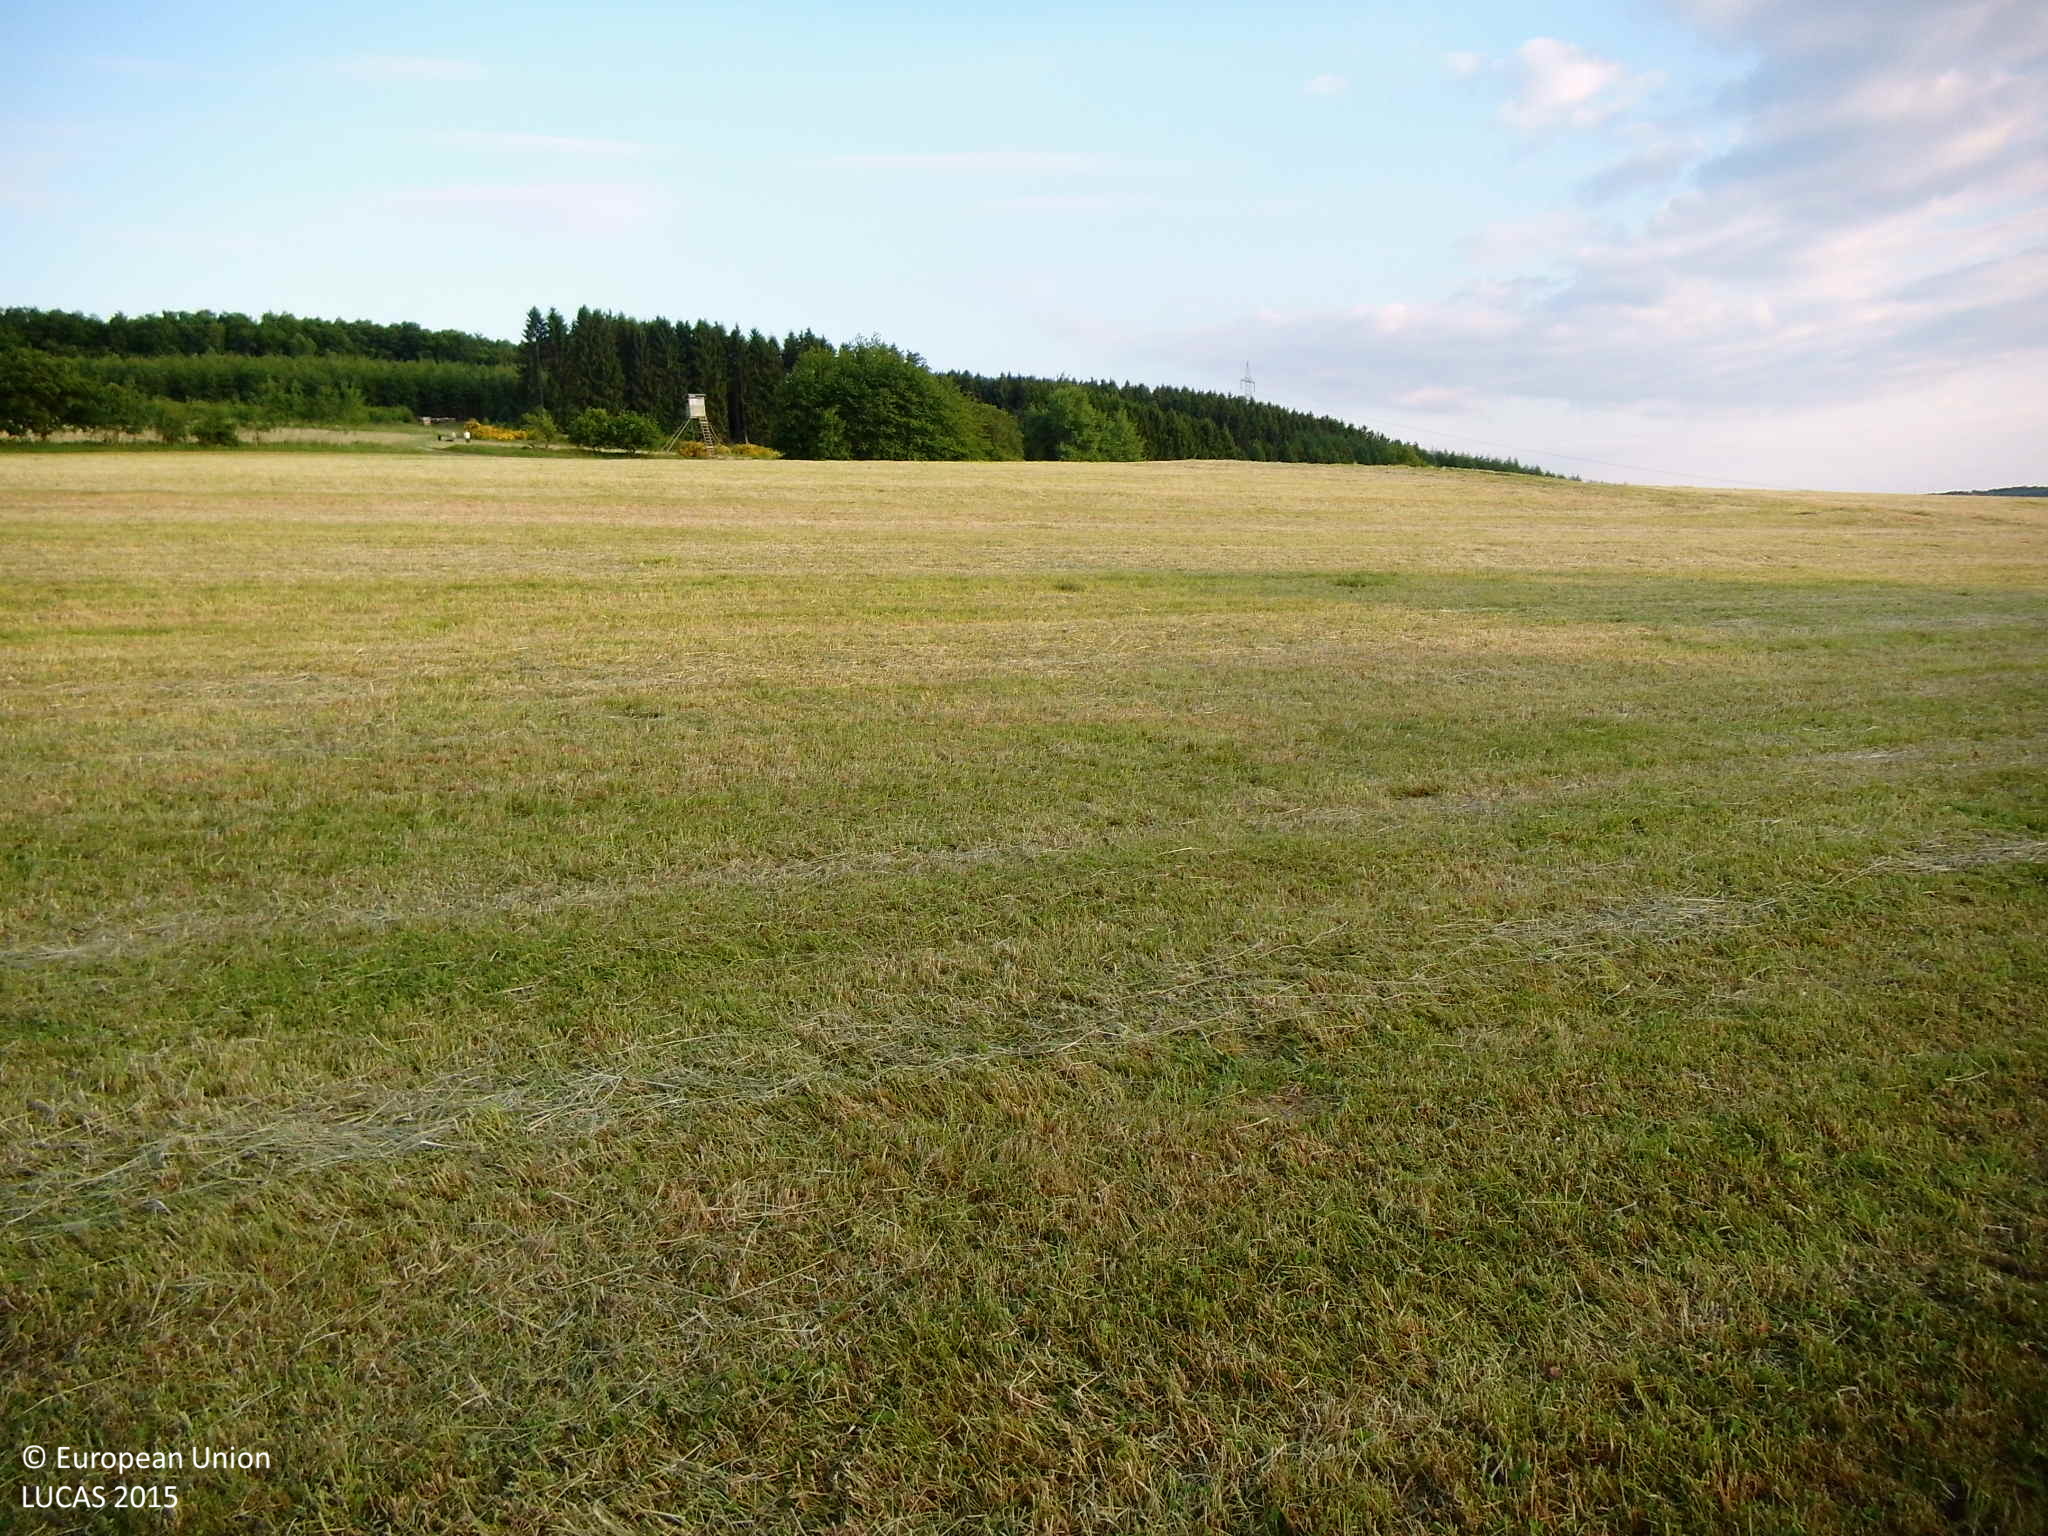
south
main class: Grassland
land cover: Grassland without tree/shrub cover
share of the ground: > 75 %
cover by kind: herbaceous plants 100 %
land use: Agriculture (excluding fallow land and kitchen gardens)
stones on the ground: 10 - 25 %
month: June
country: DE
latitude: 50.9235
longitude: 8.0798
